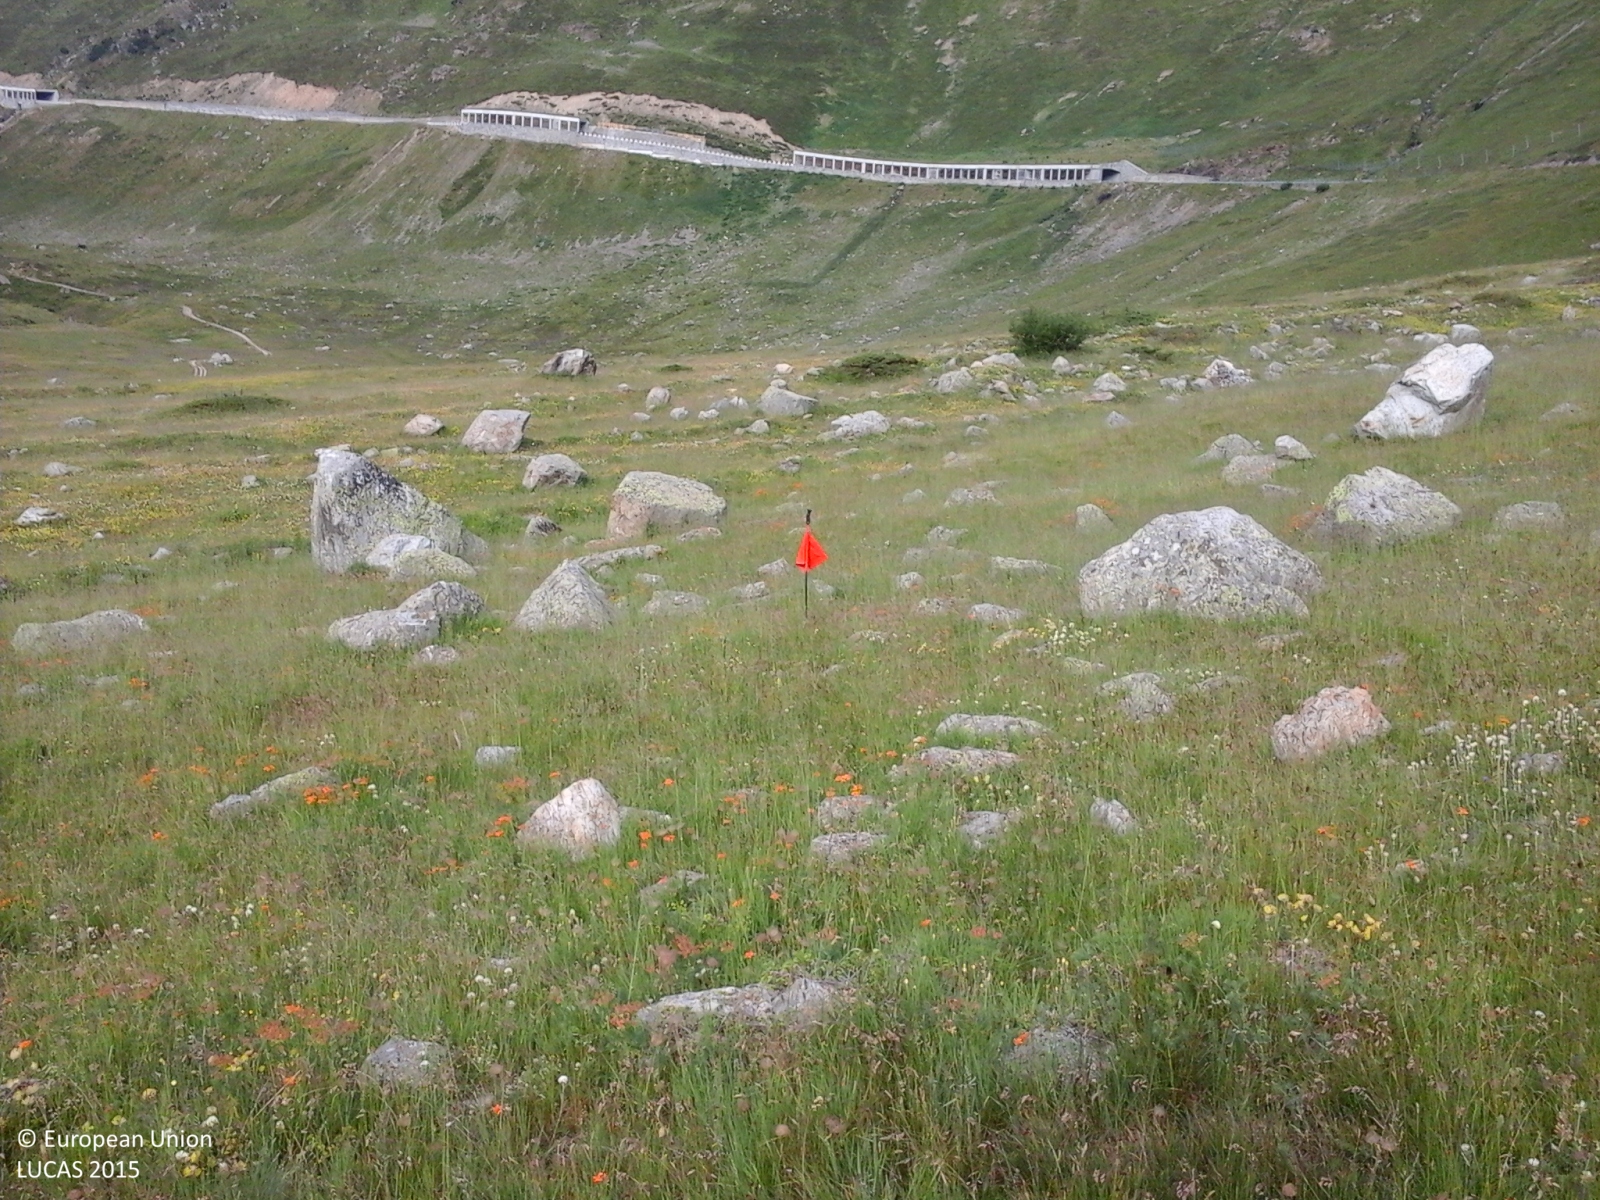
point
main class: Grassland
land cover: Grassland without tree/shrub cover
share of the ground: > 75 %
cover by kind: herbaceous plants 100 %
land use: Agriculture (excluding fallow land and kitchen gardens)
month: July
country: IT
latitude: 46.4592
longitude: 10.0650
